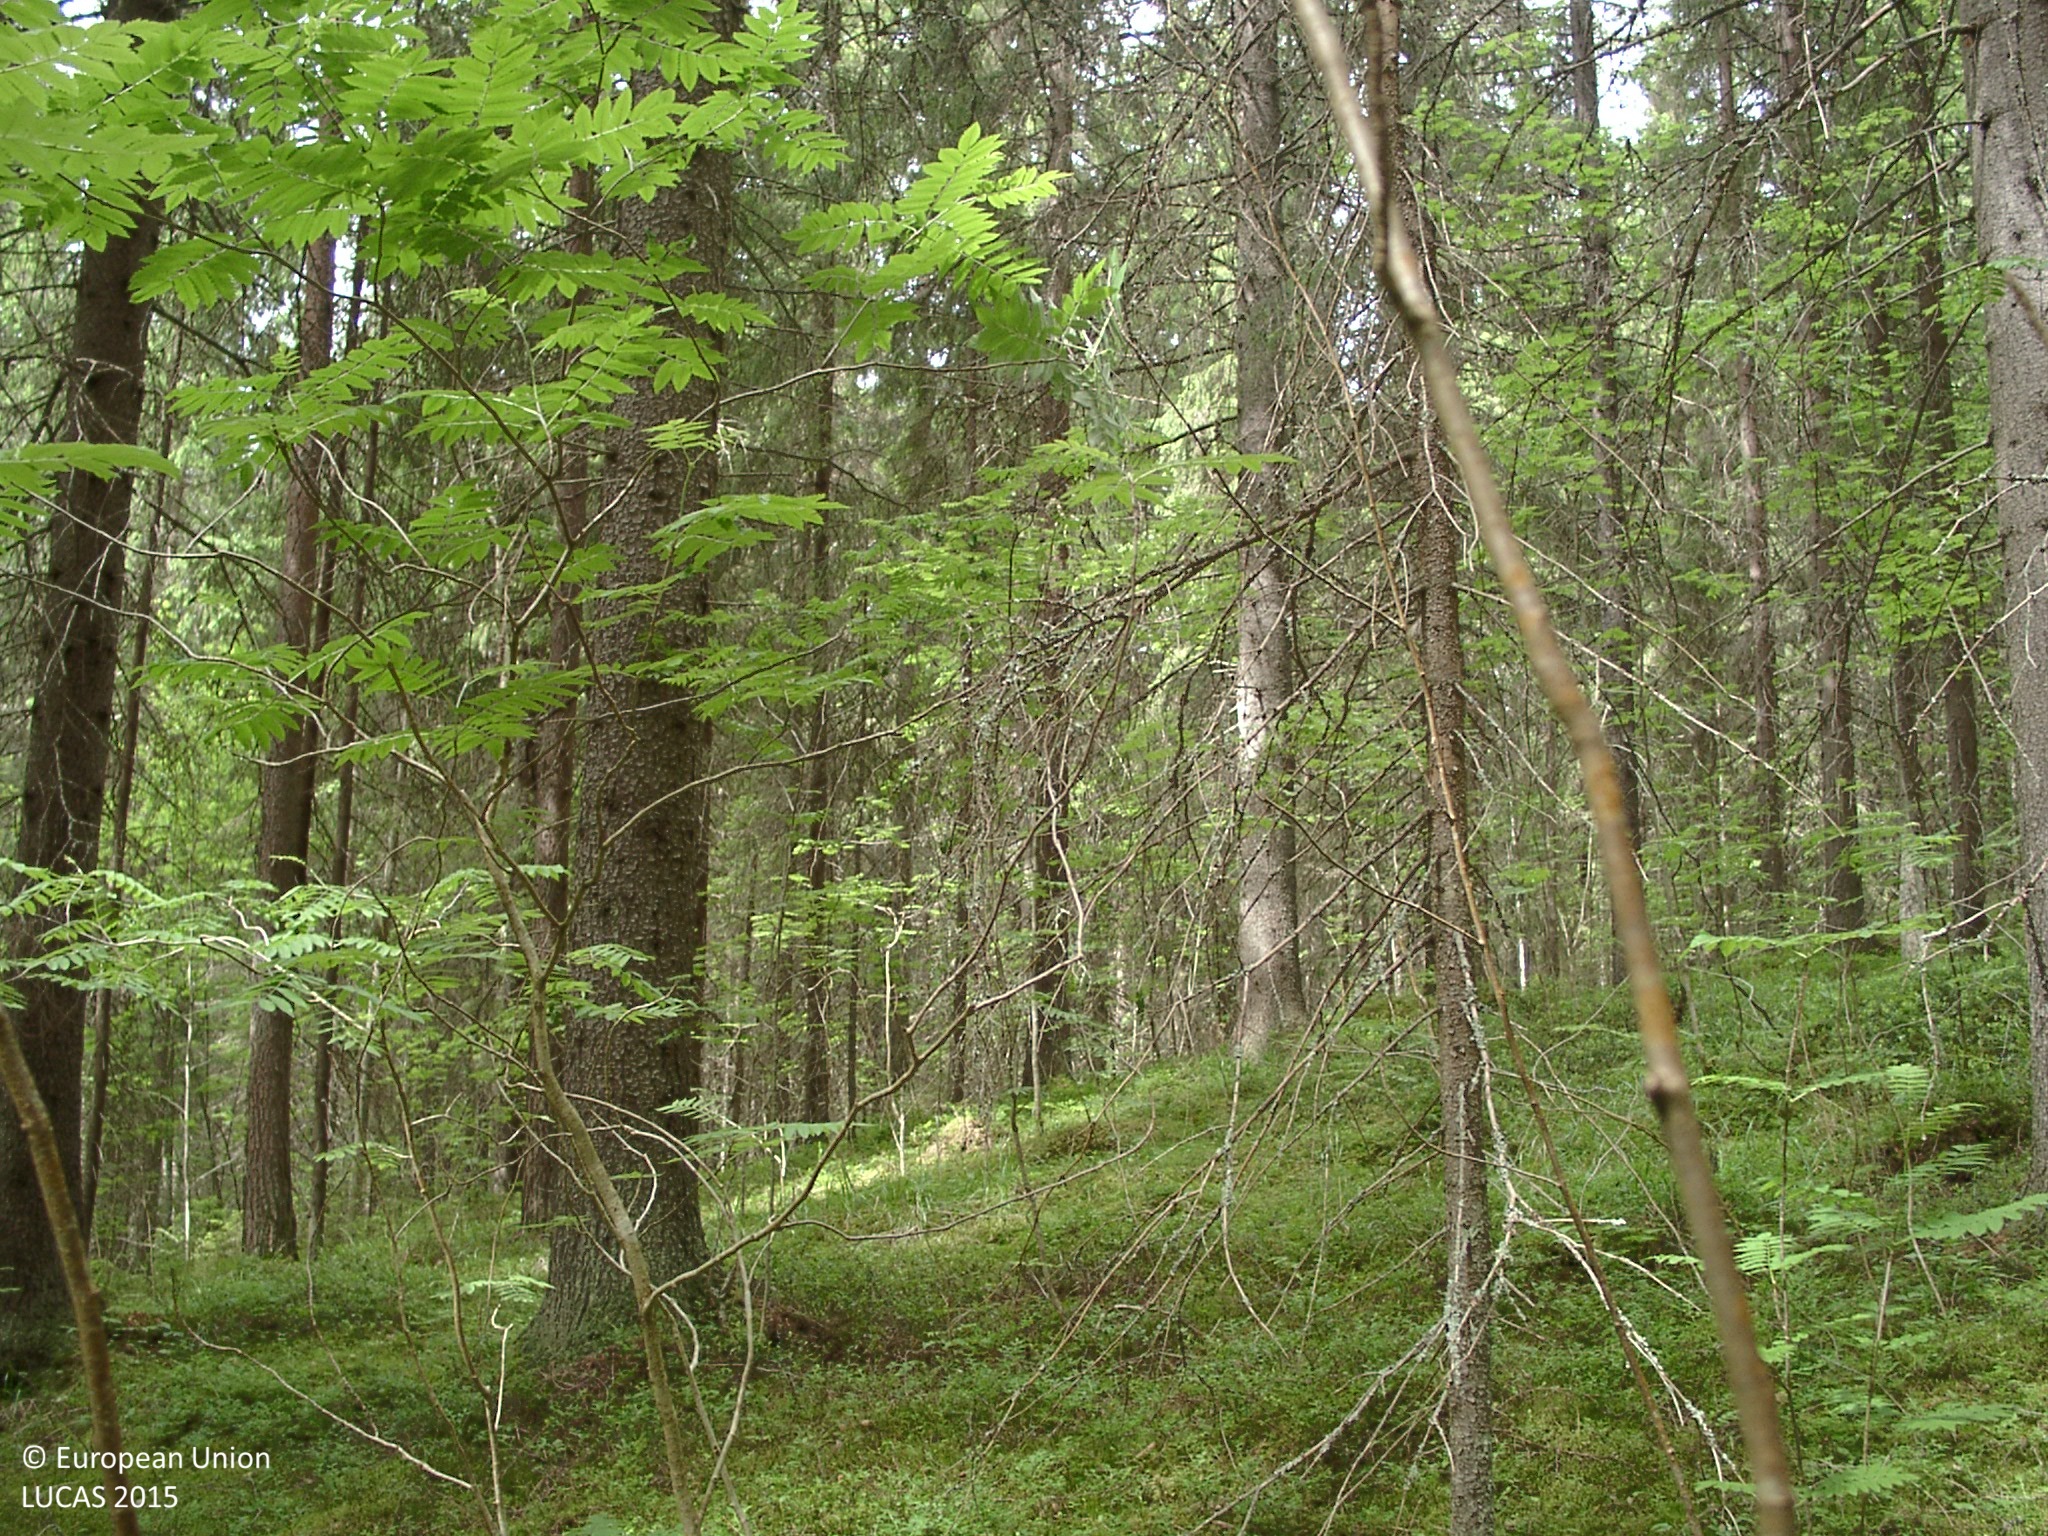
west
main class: Woodland
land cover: Spruce dominated coniferous woodland
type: boreal forest
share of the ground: 50 - 75 %
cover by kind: coniferous forest trees 60 %, shrubs 20 %, broadleaved forest trees 10 %, lichens and mosses 10 %
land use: Forestry
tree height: > 5 m
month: July
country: FI
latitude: 61.9907
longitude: 25.2865
